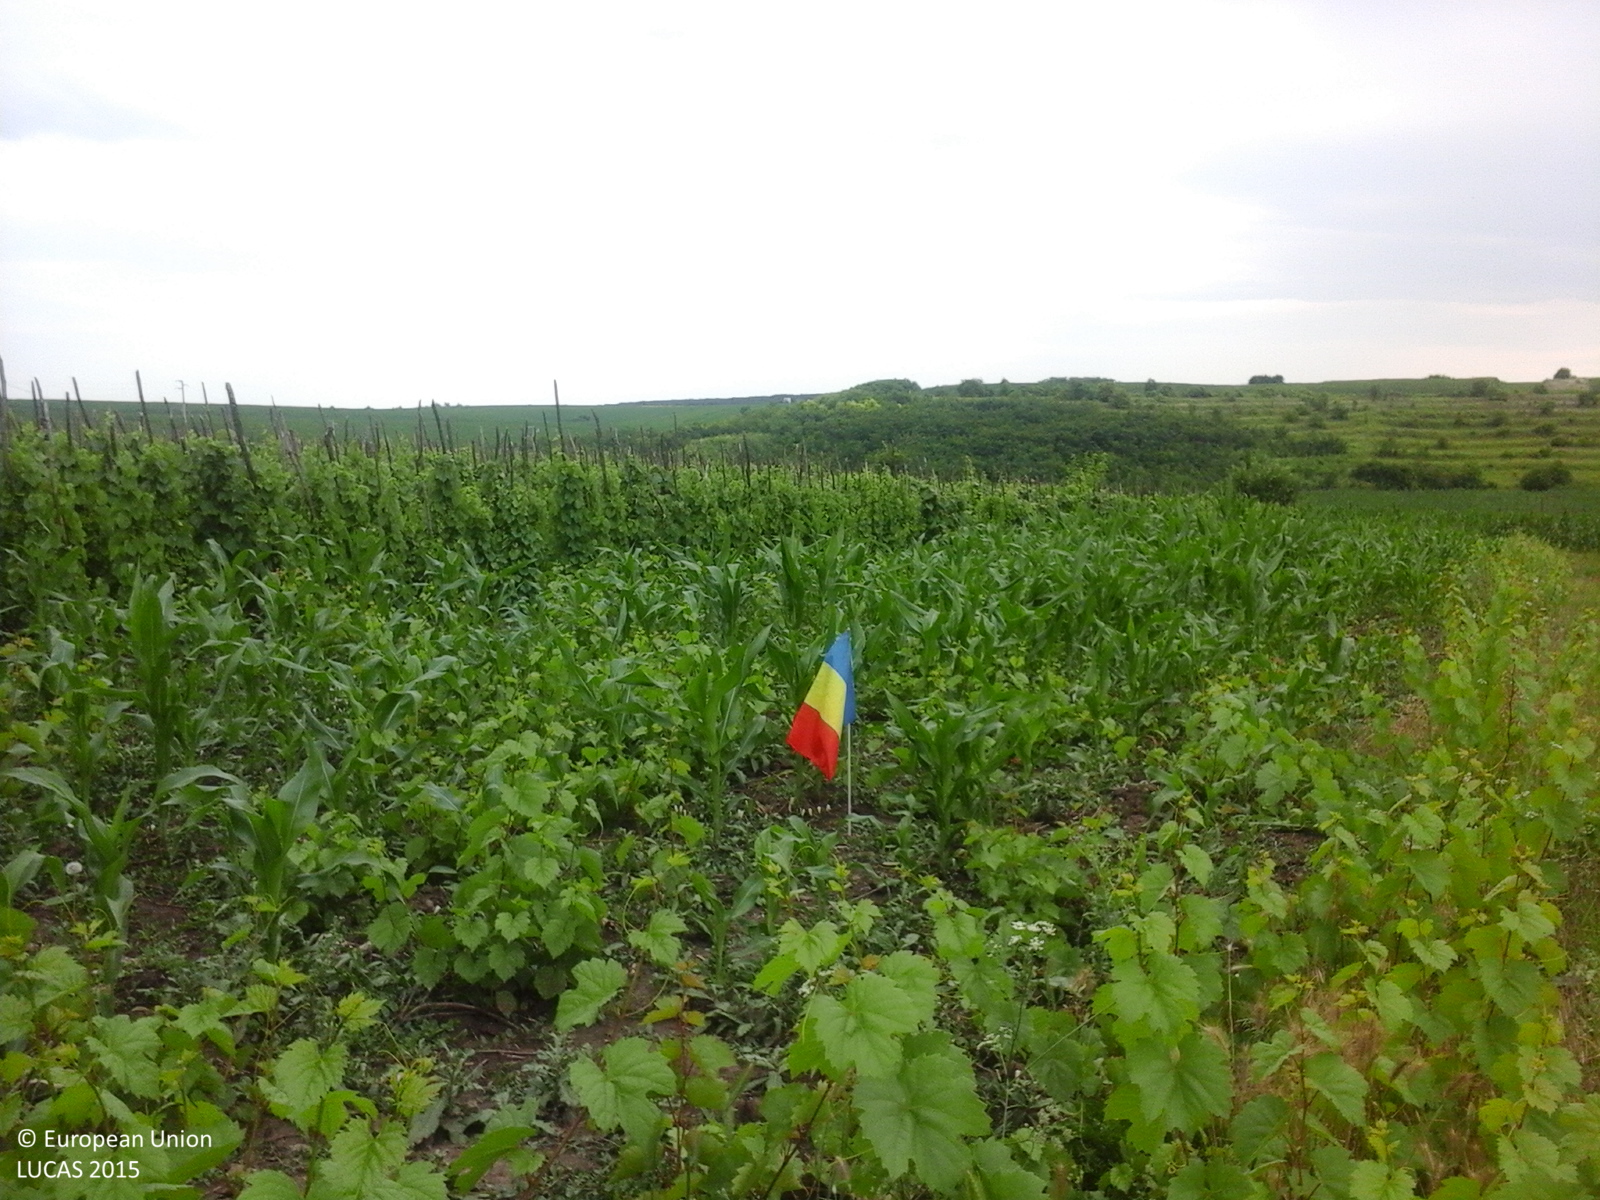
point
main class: Cropland
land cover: Vineyards
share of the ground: 10 - 25 %
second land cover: Maize
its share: 50 - 75 %
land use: Agriculture (excluding fallow land and kitchen gardens)
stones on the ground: < 10 %
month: June
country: RO
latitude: 44.1244
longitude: 26.1364
